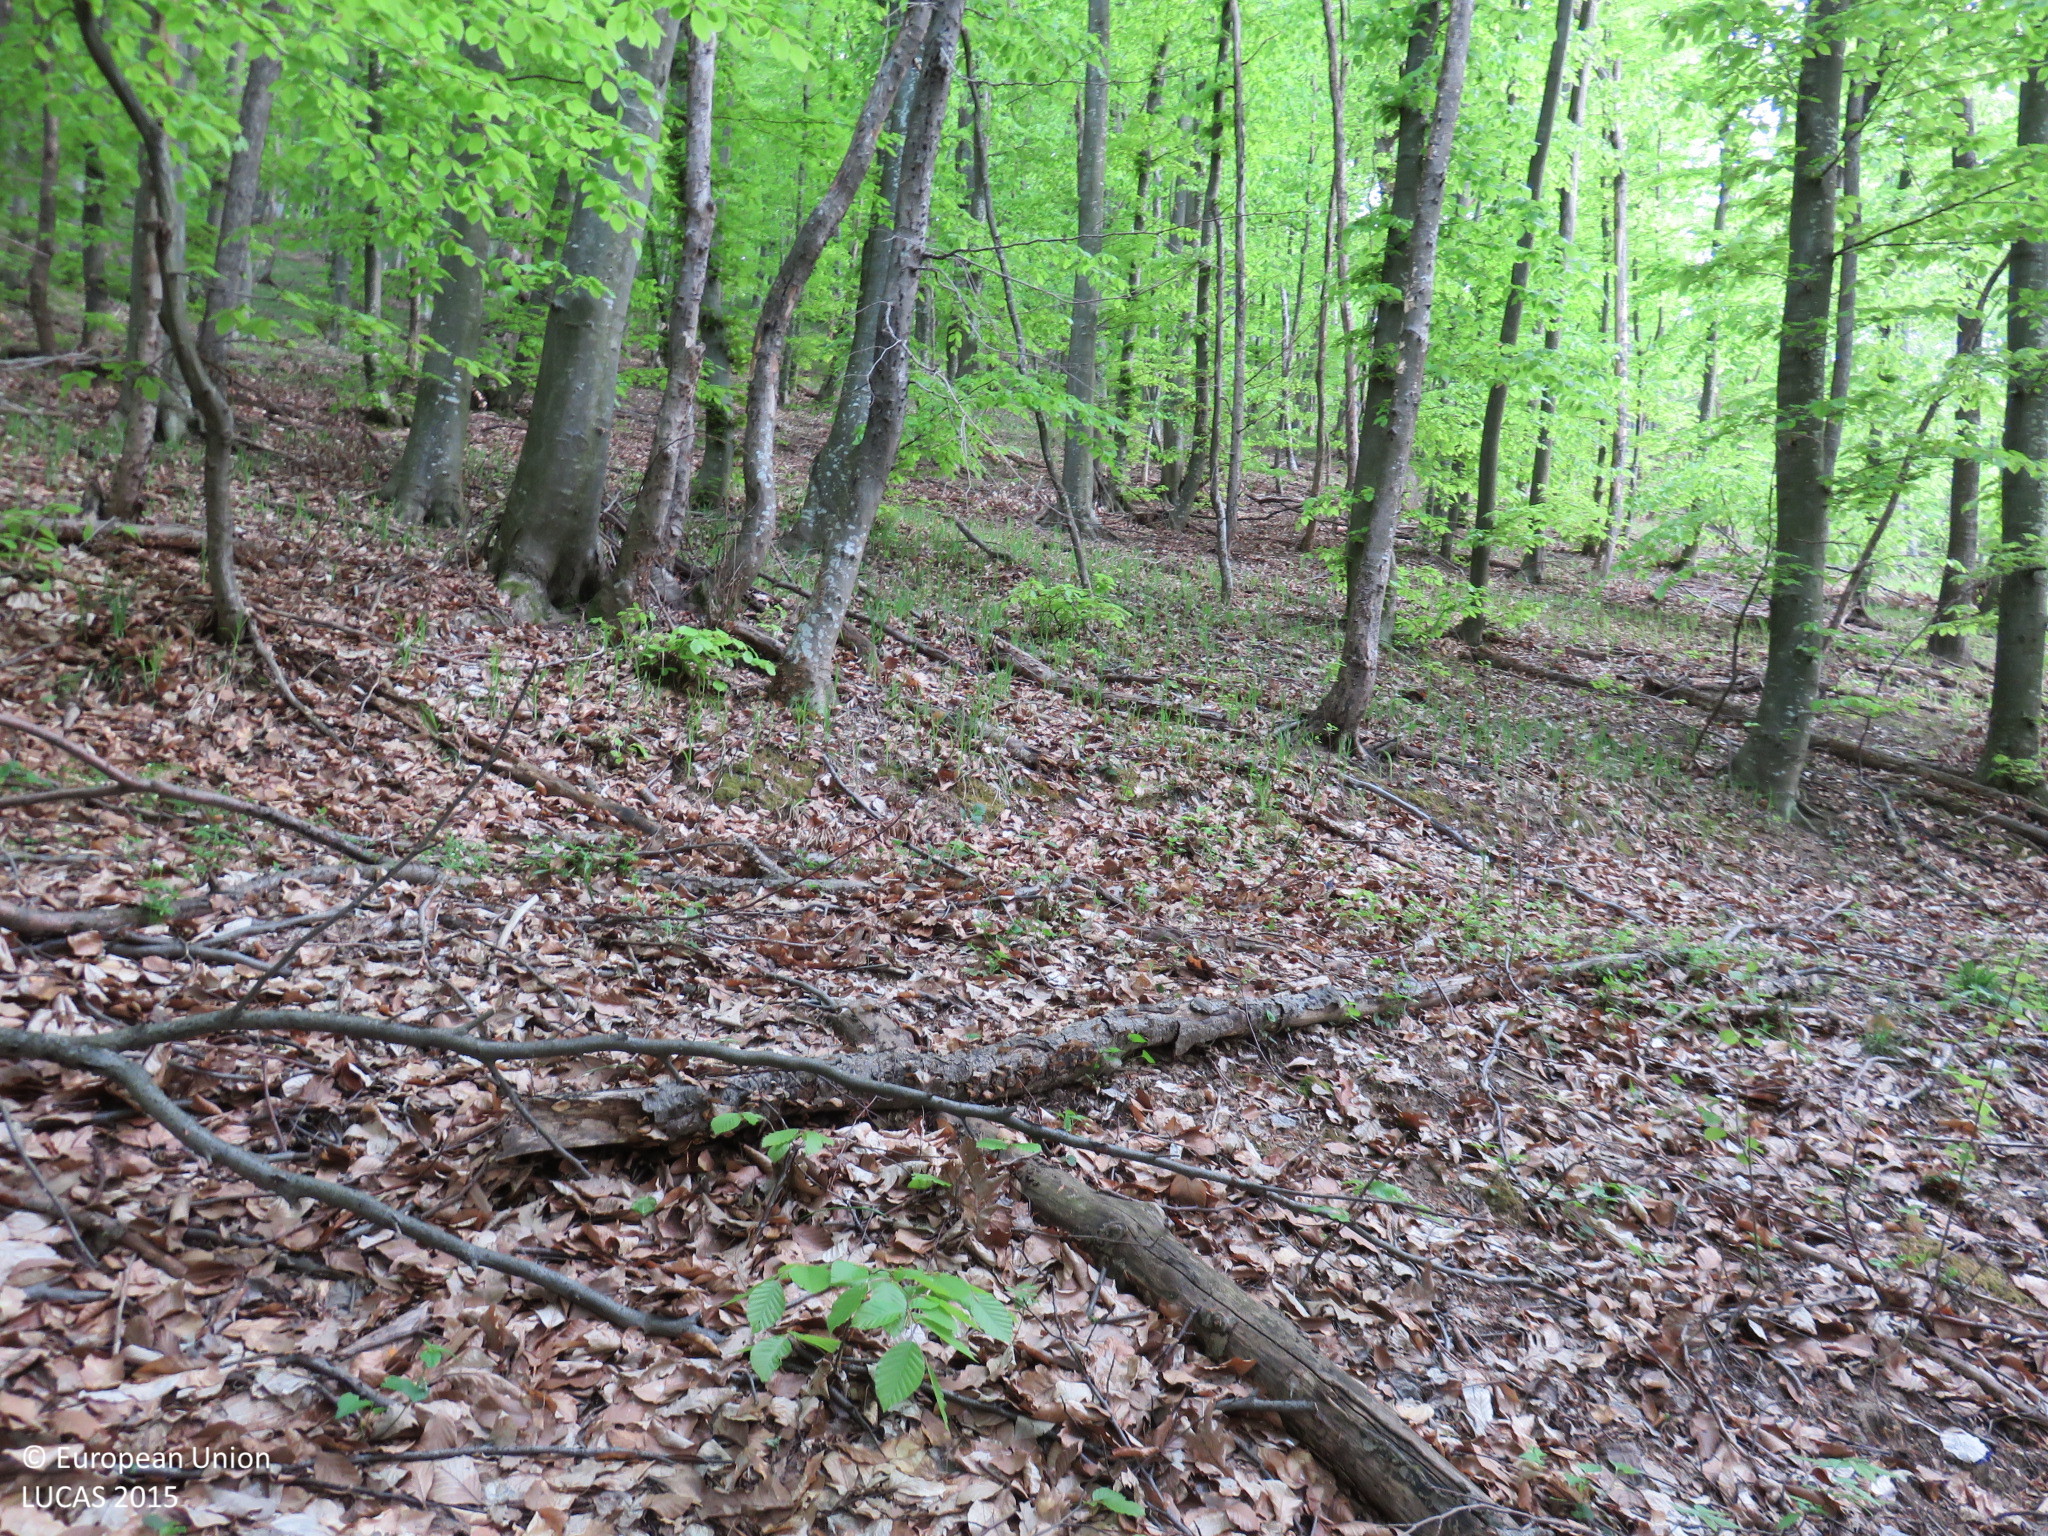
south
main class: Woodland
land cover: Broadleaved woodland
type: beech forest
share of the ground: > 75 %
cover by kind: broadleaved forest trees 80 %, unconsolidated bare surface 20 %
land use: Forestry
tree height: > 5 m
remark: Clear cut
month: April
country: BG
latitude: 43.0187
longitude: 24.8490
